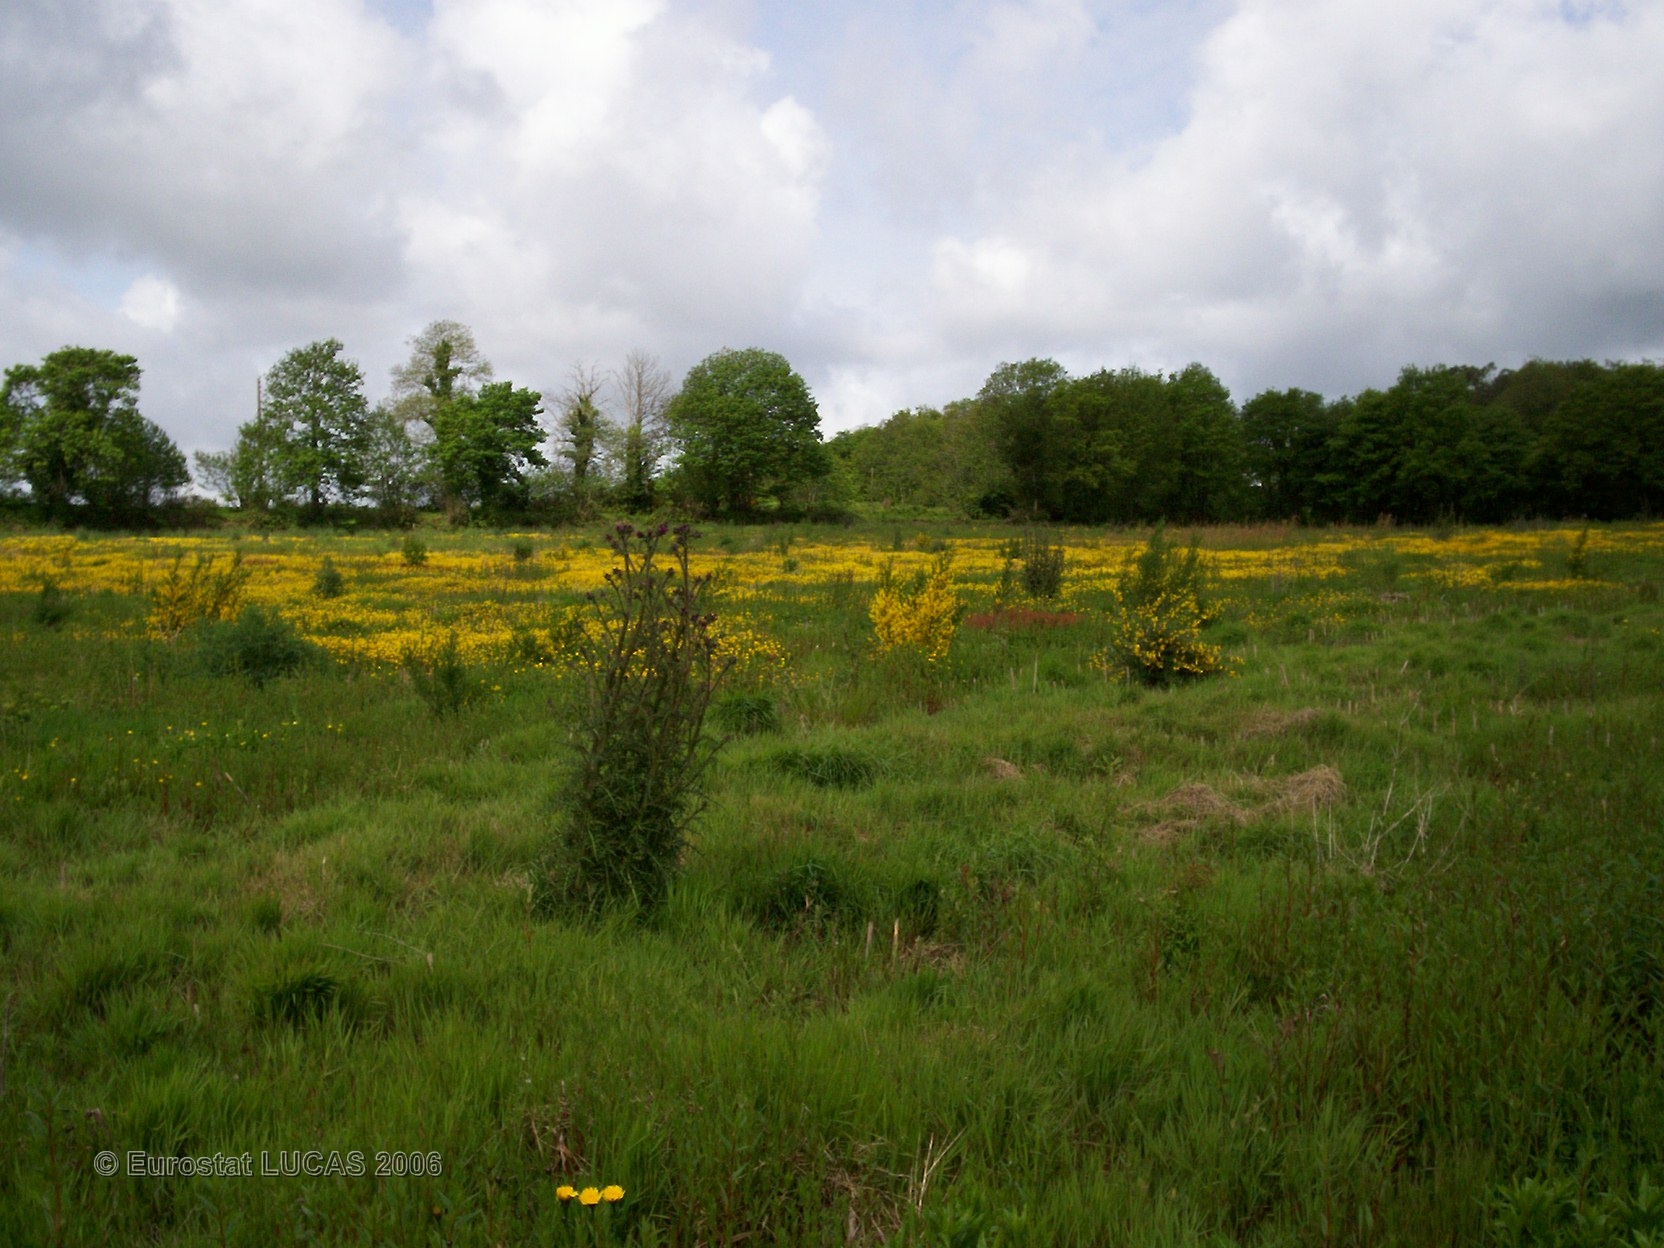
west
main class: Grassland
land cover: Grassland without tree/shrub cover
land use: Fallow land
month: May
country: FR
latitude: 48.0123
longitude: -3.9058
